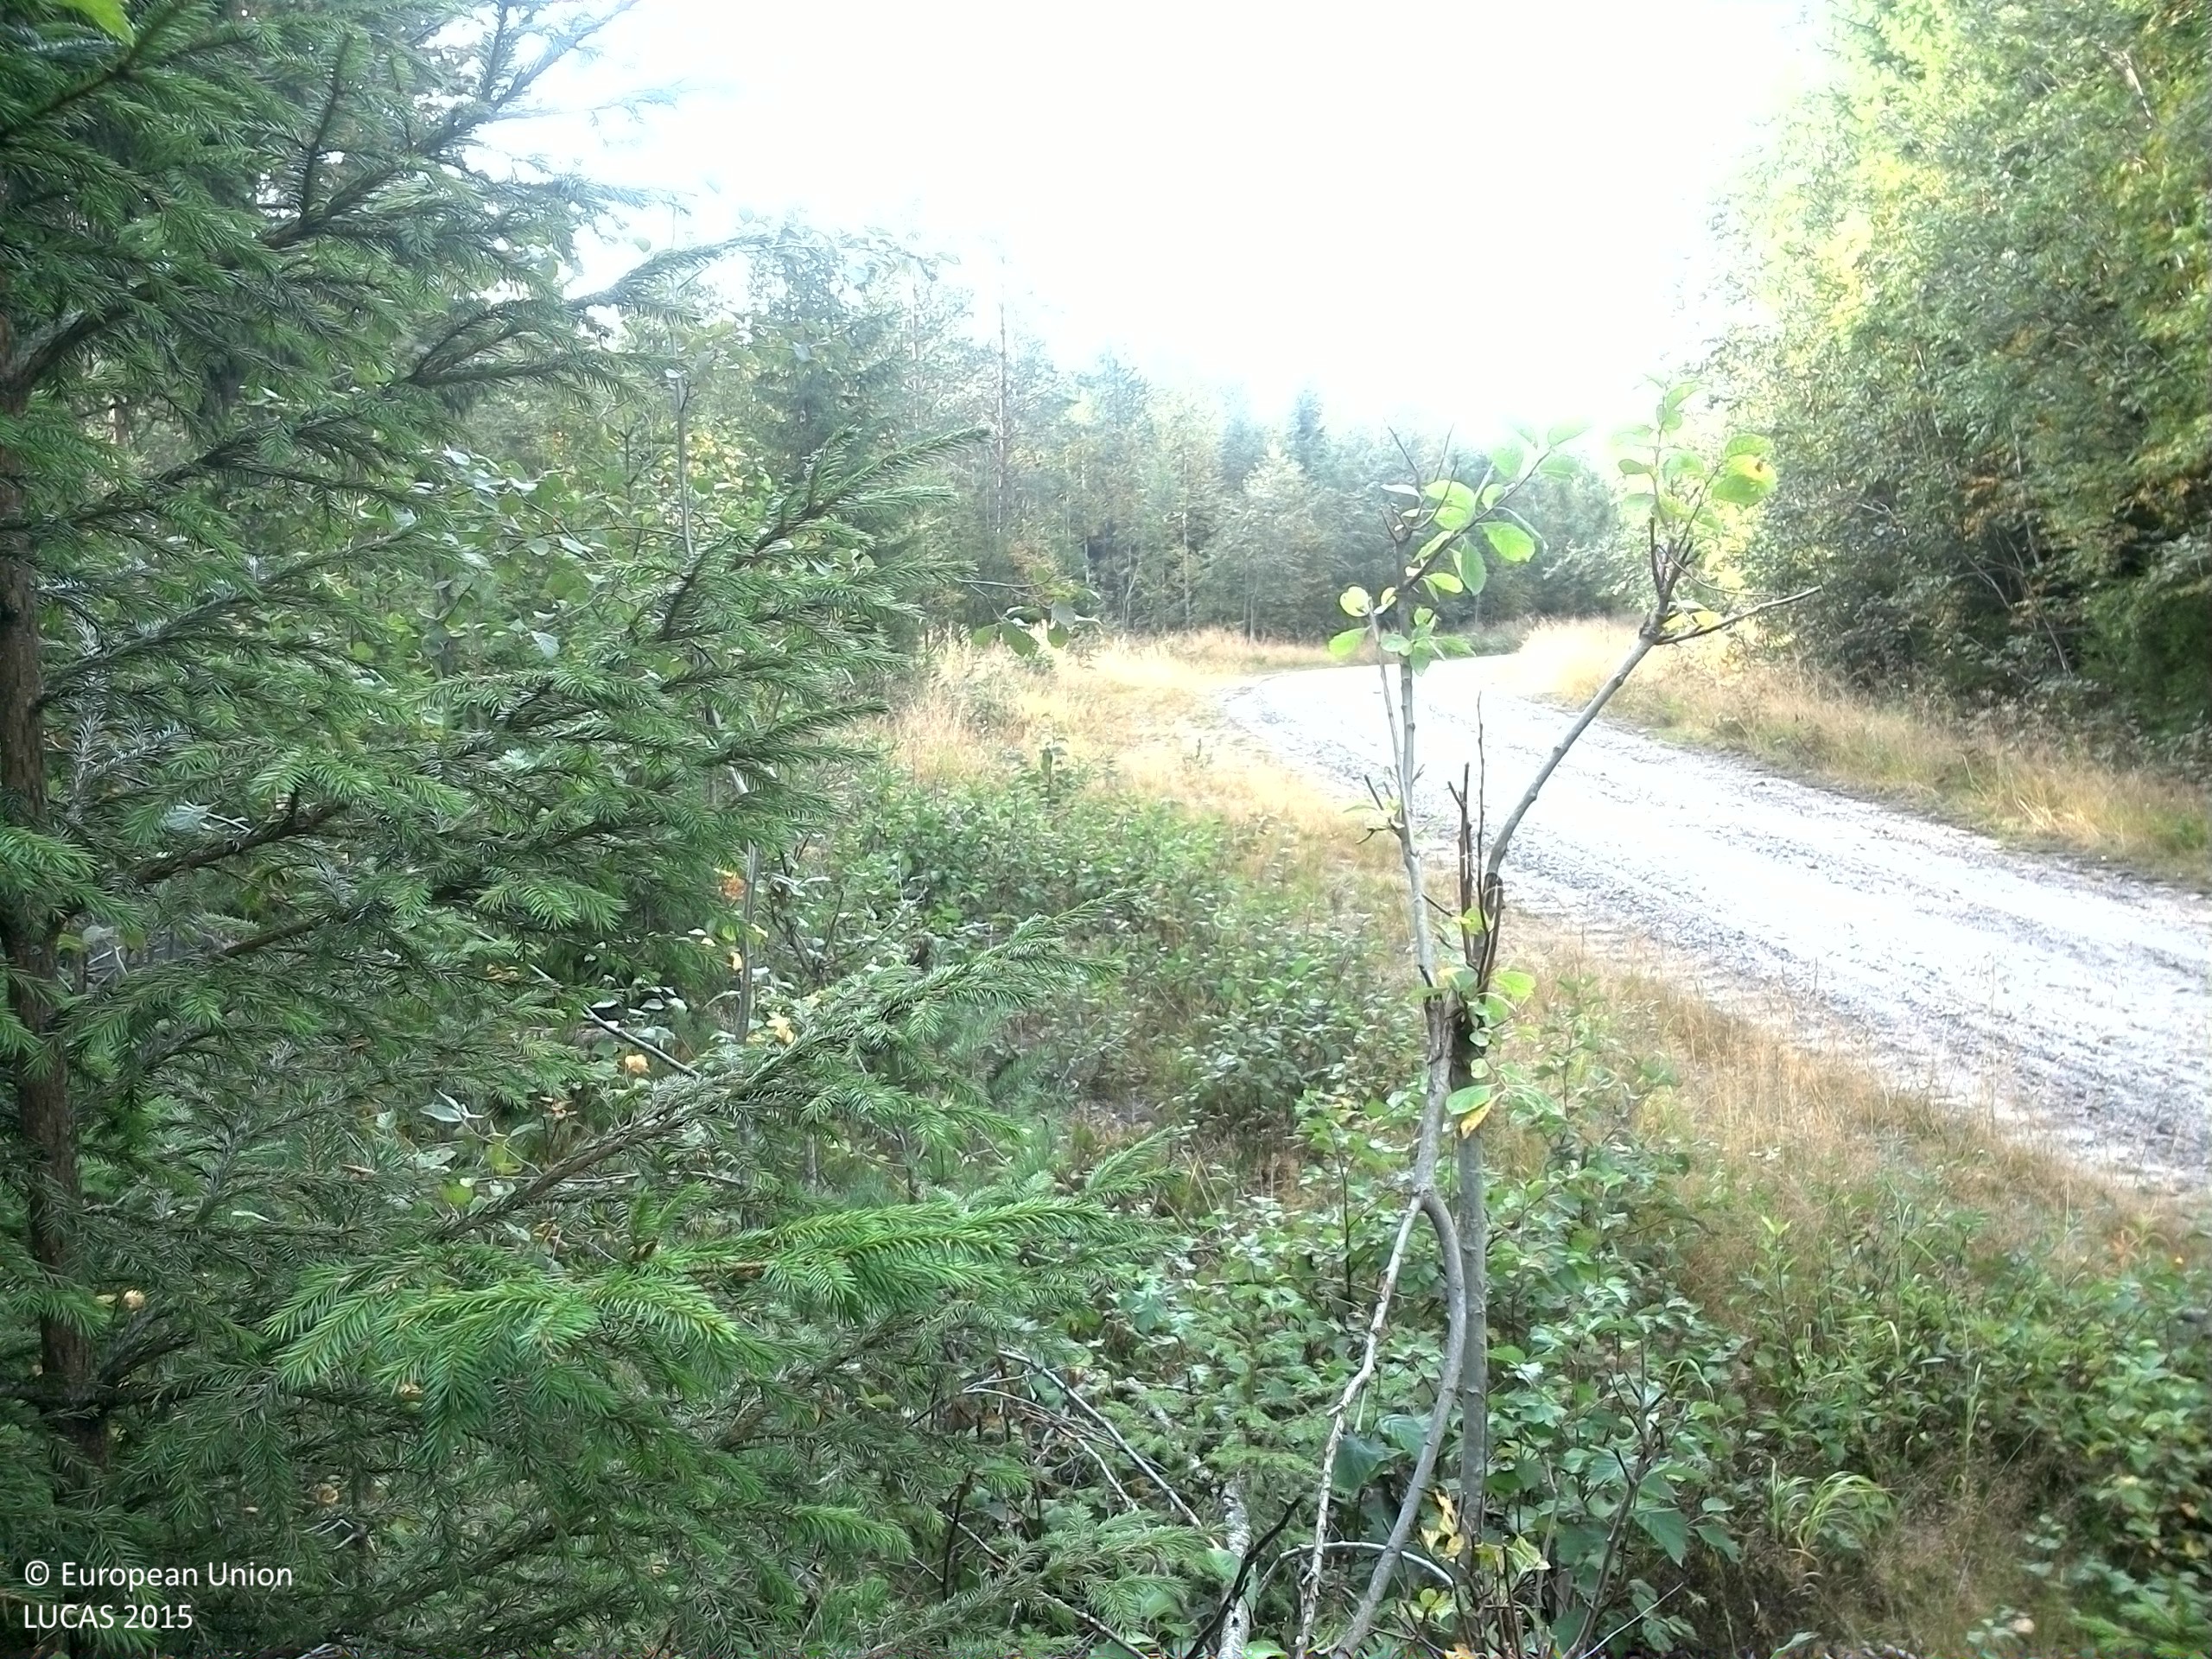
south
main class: Woodland
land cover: Other mixed woodland
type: boreal forest
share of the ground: 25 - 50 %
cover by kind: shrubs 30 %, coniferous forest trees 20 %, broadleaved forest trees 20 %, lichens and mosses 15 %, herbaceous plants 10 %, consolidated bare surface 5 %
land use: Forestry
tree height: > 5 m
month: September
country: SE
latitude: 61.6316
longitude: 15.3605
